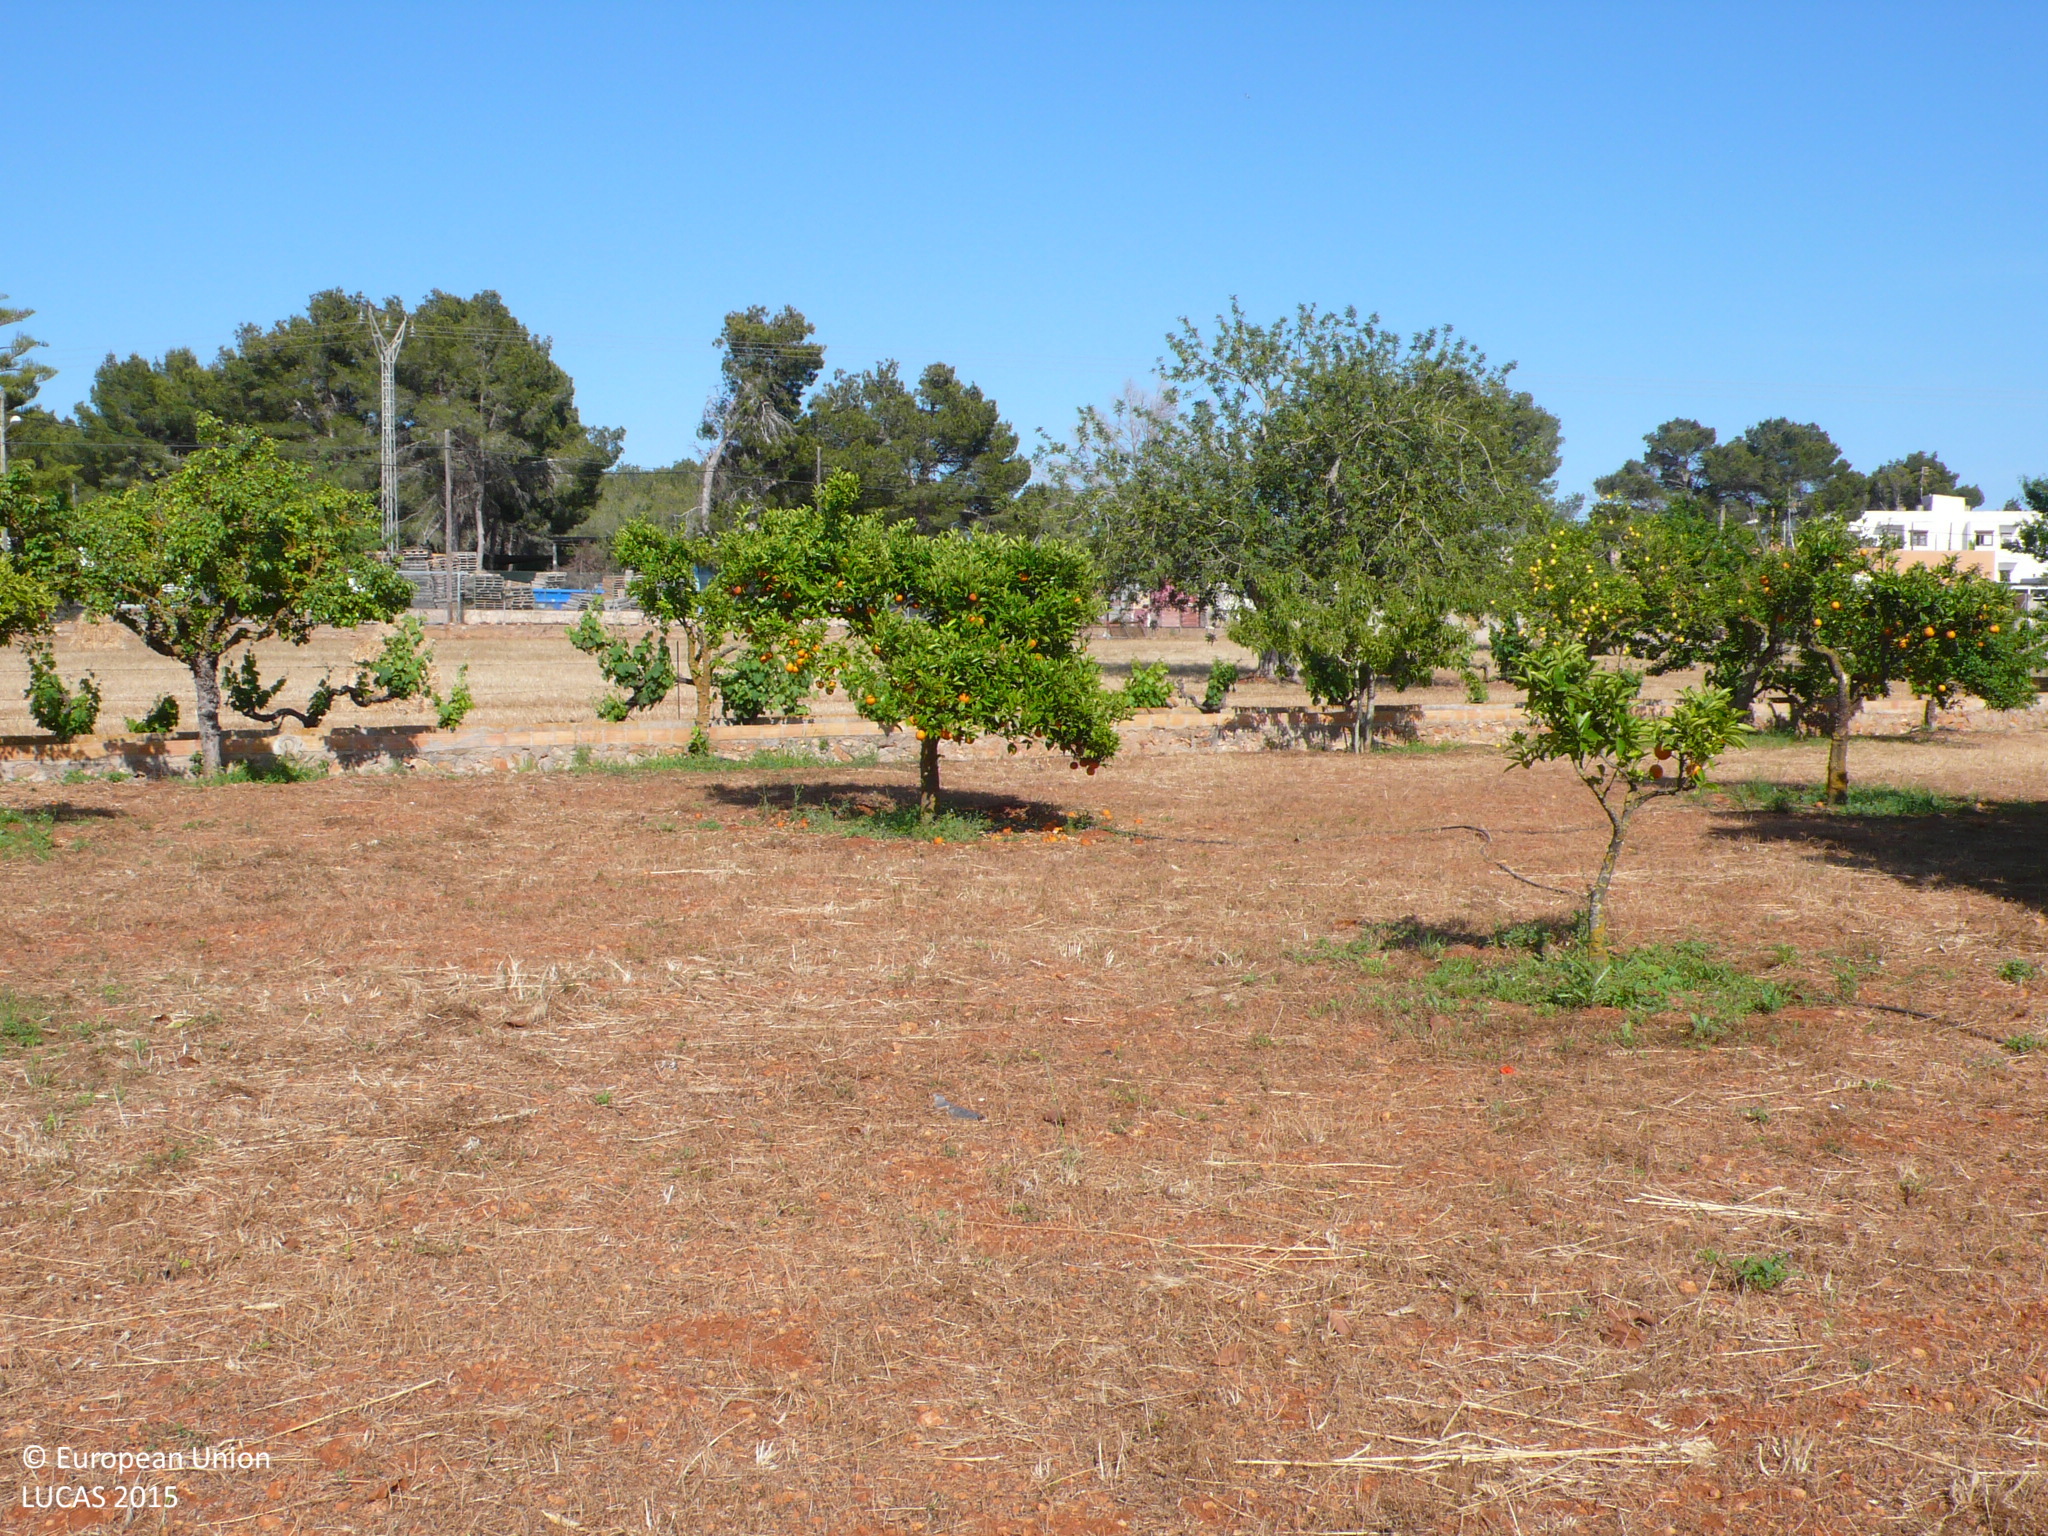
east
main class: Cropland
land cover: Other citrus fruit
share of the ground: 10 - 25 %
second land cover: Other bare soil
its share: > 75 %
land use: Kitchen garden
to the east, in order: Other citrus fruit; Other bare soil; Fences; Oats; Electric lines; Oats; Paved roads, cycling and walking lanes; Artificial constructions in urban areas; Pine dominated coniferous woodland; Tracks; Pine dominated coniferous woodland; Paved roads, cycling and walking lanes; Pine dominated coniferous woodland; Fences; Grassland with sparse tree/shrub cover; Fences
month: May
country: ES
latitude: 39.0103
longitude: 1.5469
